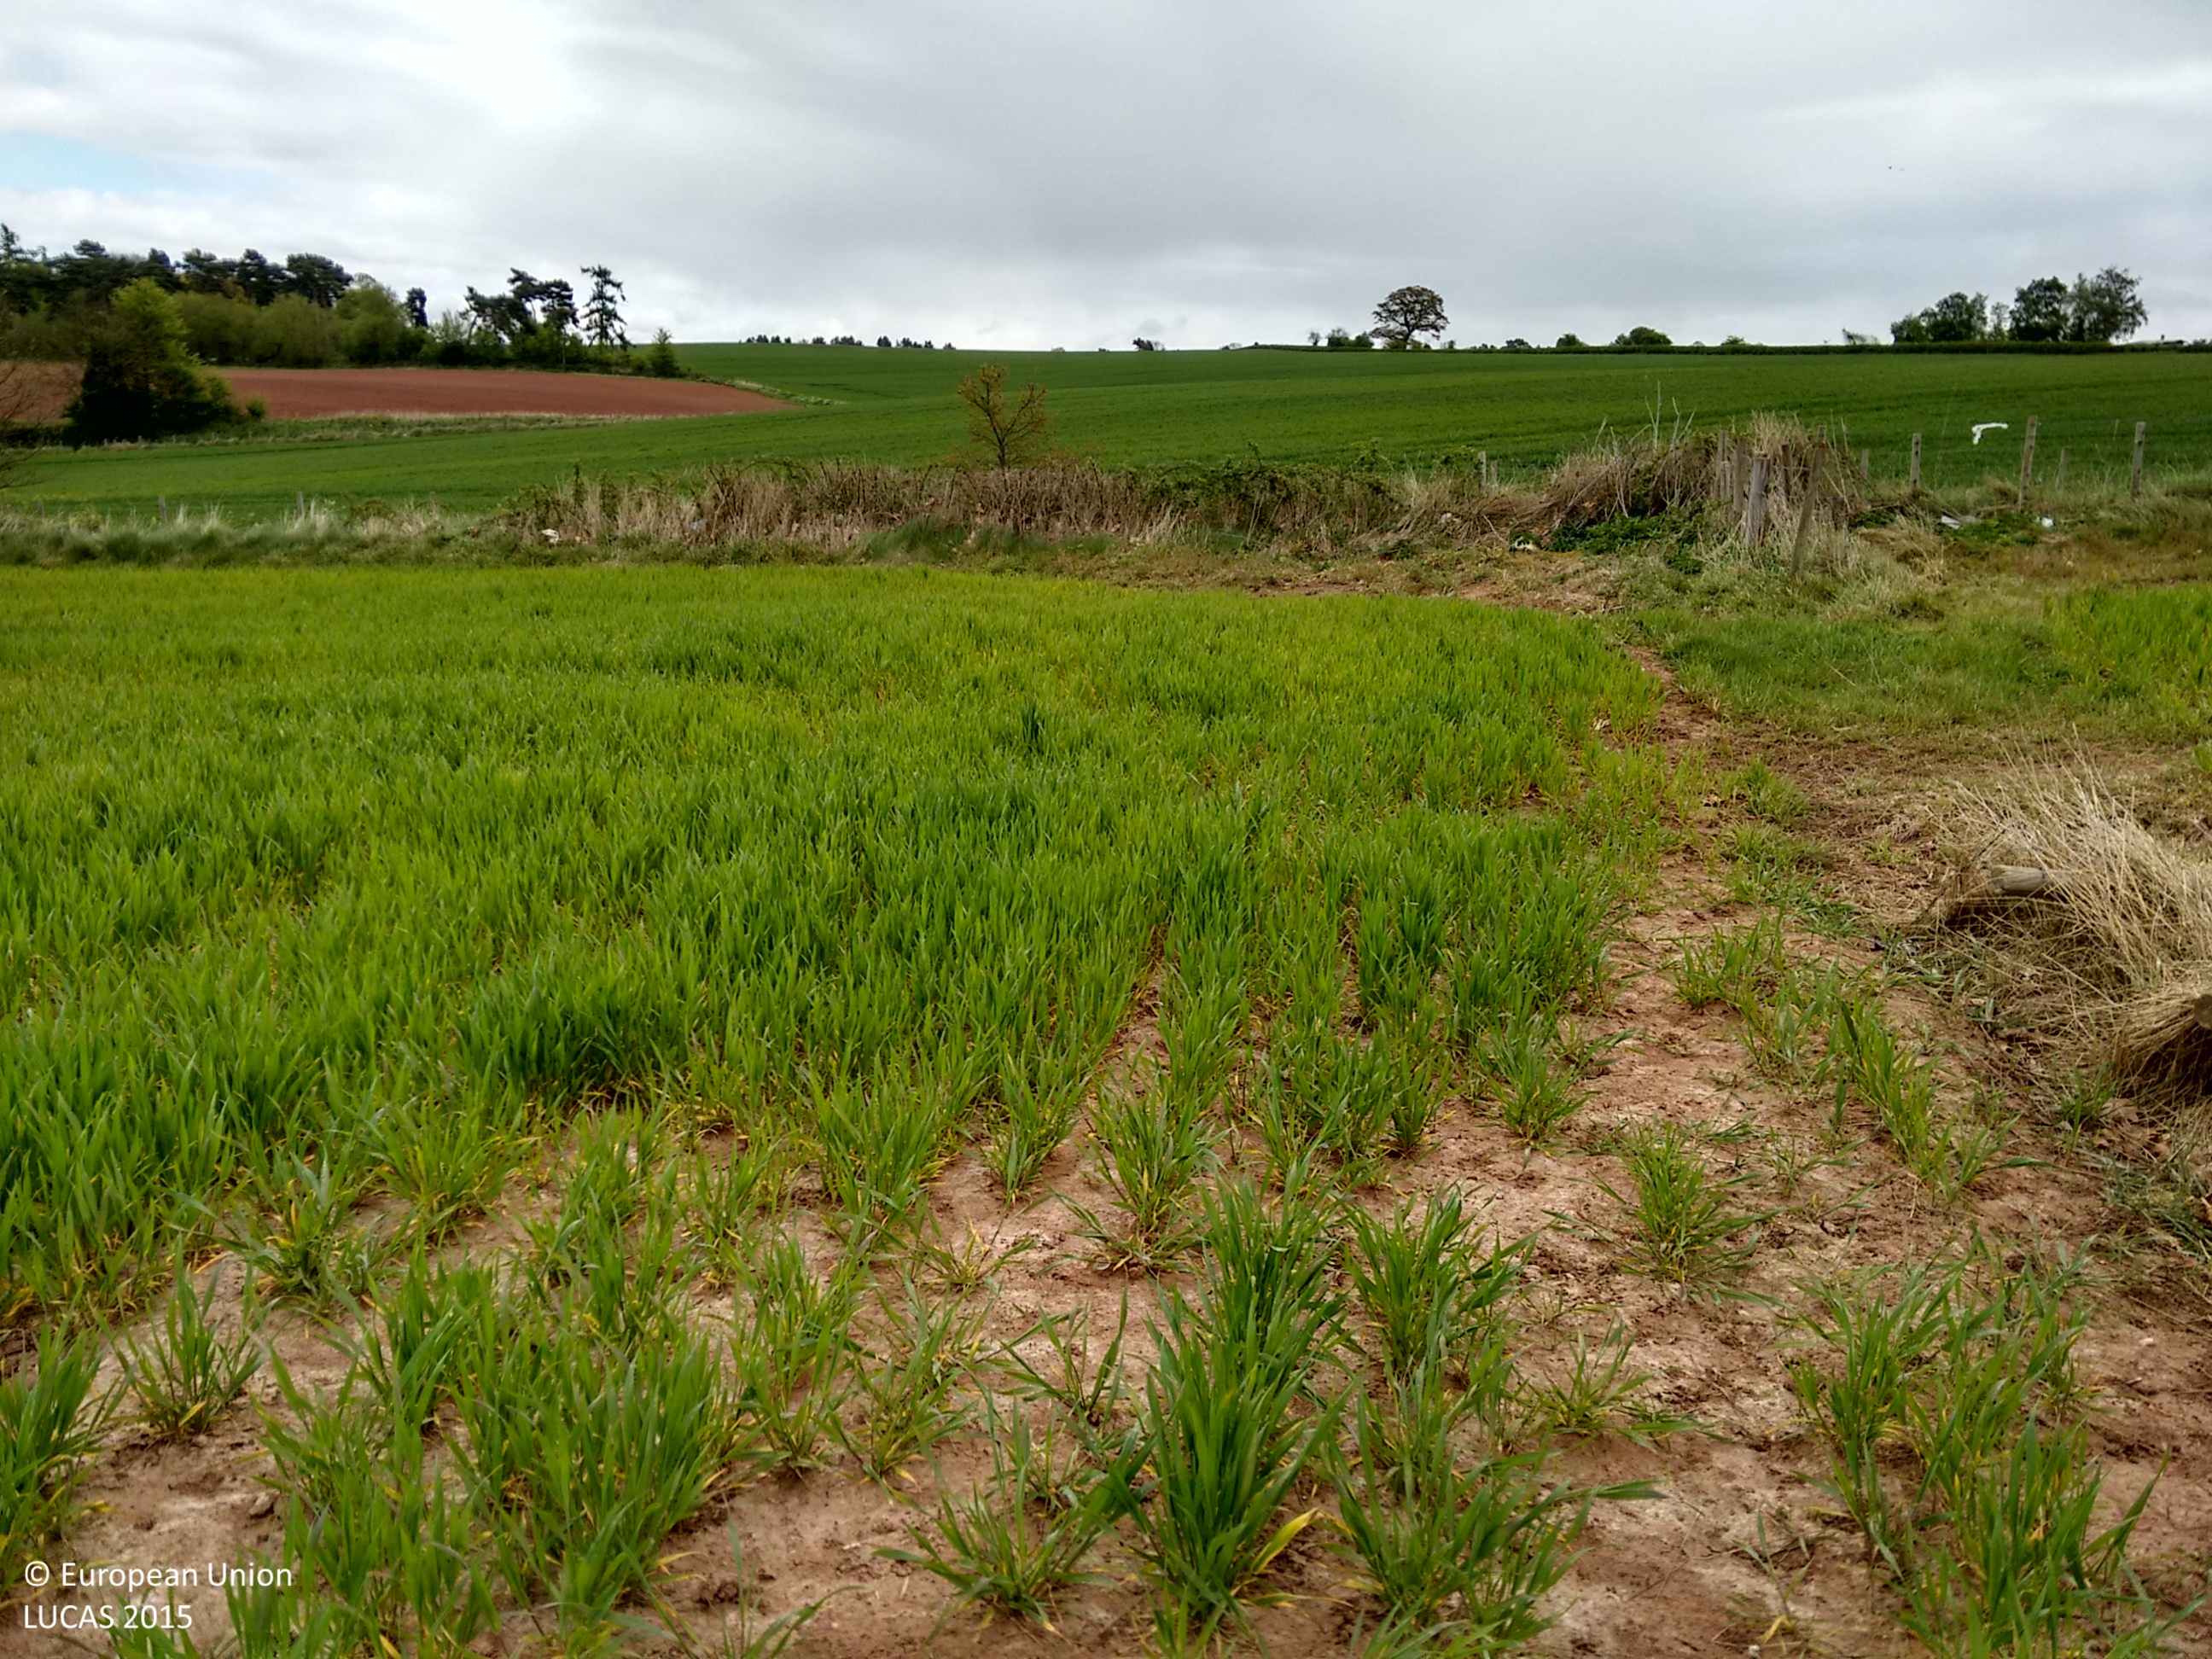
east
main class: Cropland
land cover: Common wheat
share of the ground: 25 - 50 %
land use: Agriculture (excluding fallow land and kitchen gardens)
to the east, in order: Common wheat; Managed hedges; Fences; Paved roads, cycling and walking lanes; Grass margins; Fences; Grass margins; Common wheat; Fences; Grass margins; Paved roads, cycling and walking lanes; Grass margins; Managed hedges; Common wheat
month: April
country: GB
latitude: 52.3632
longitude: -2.2062
